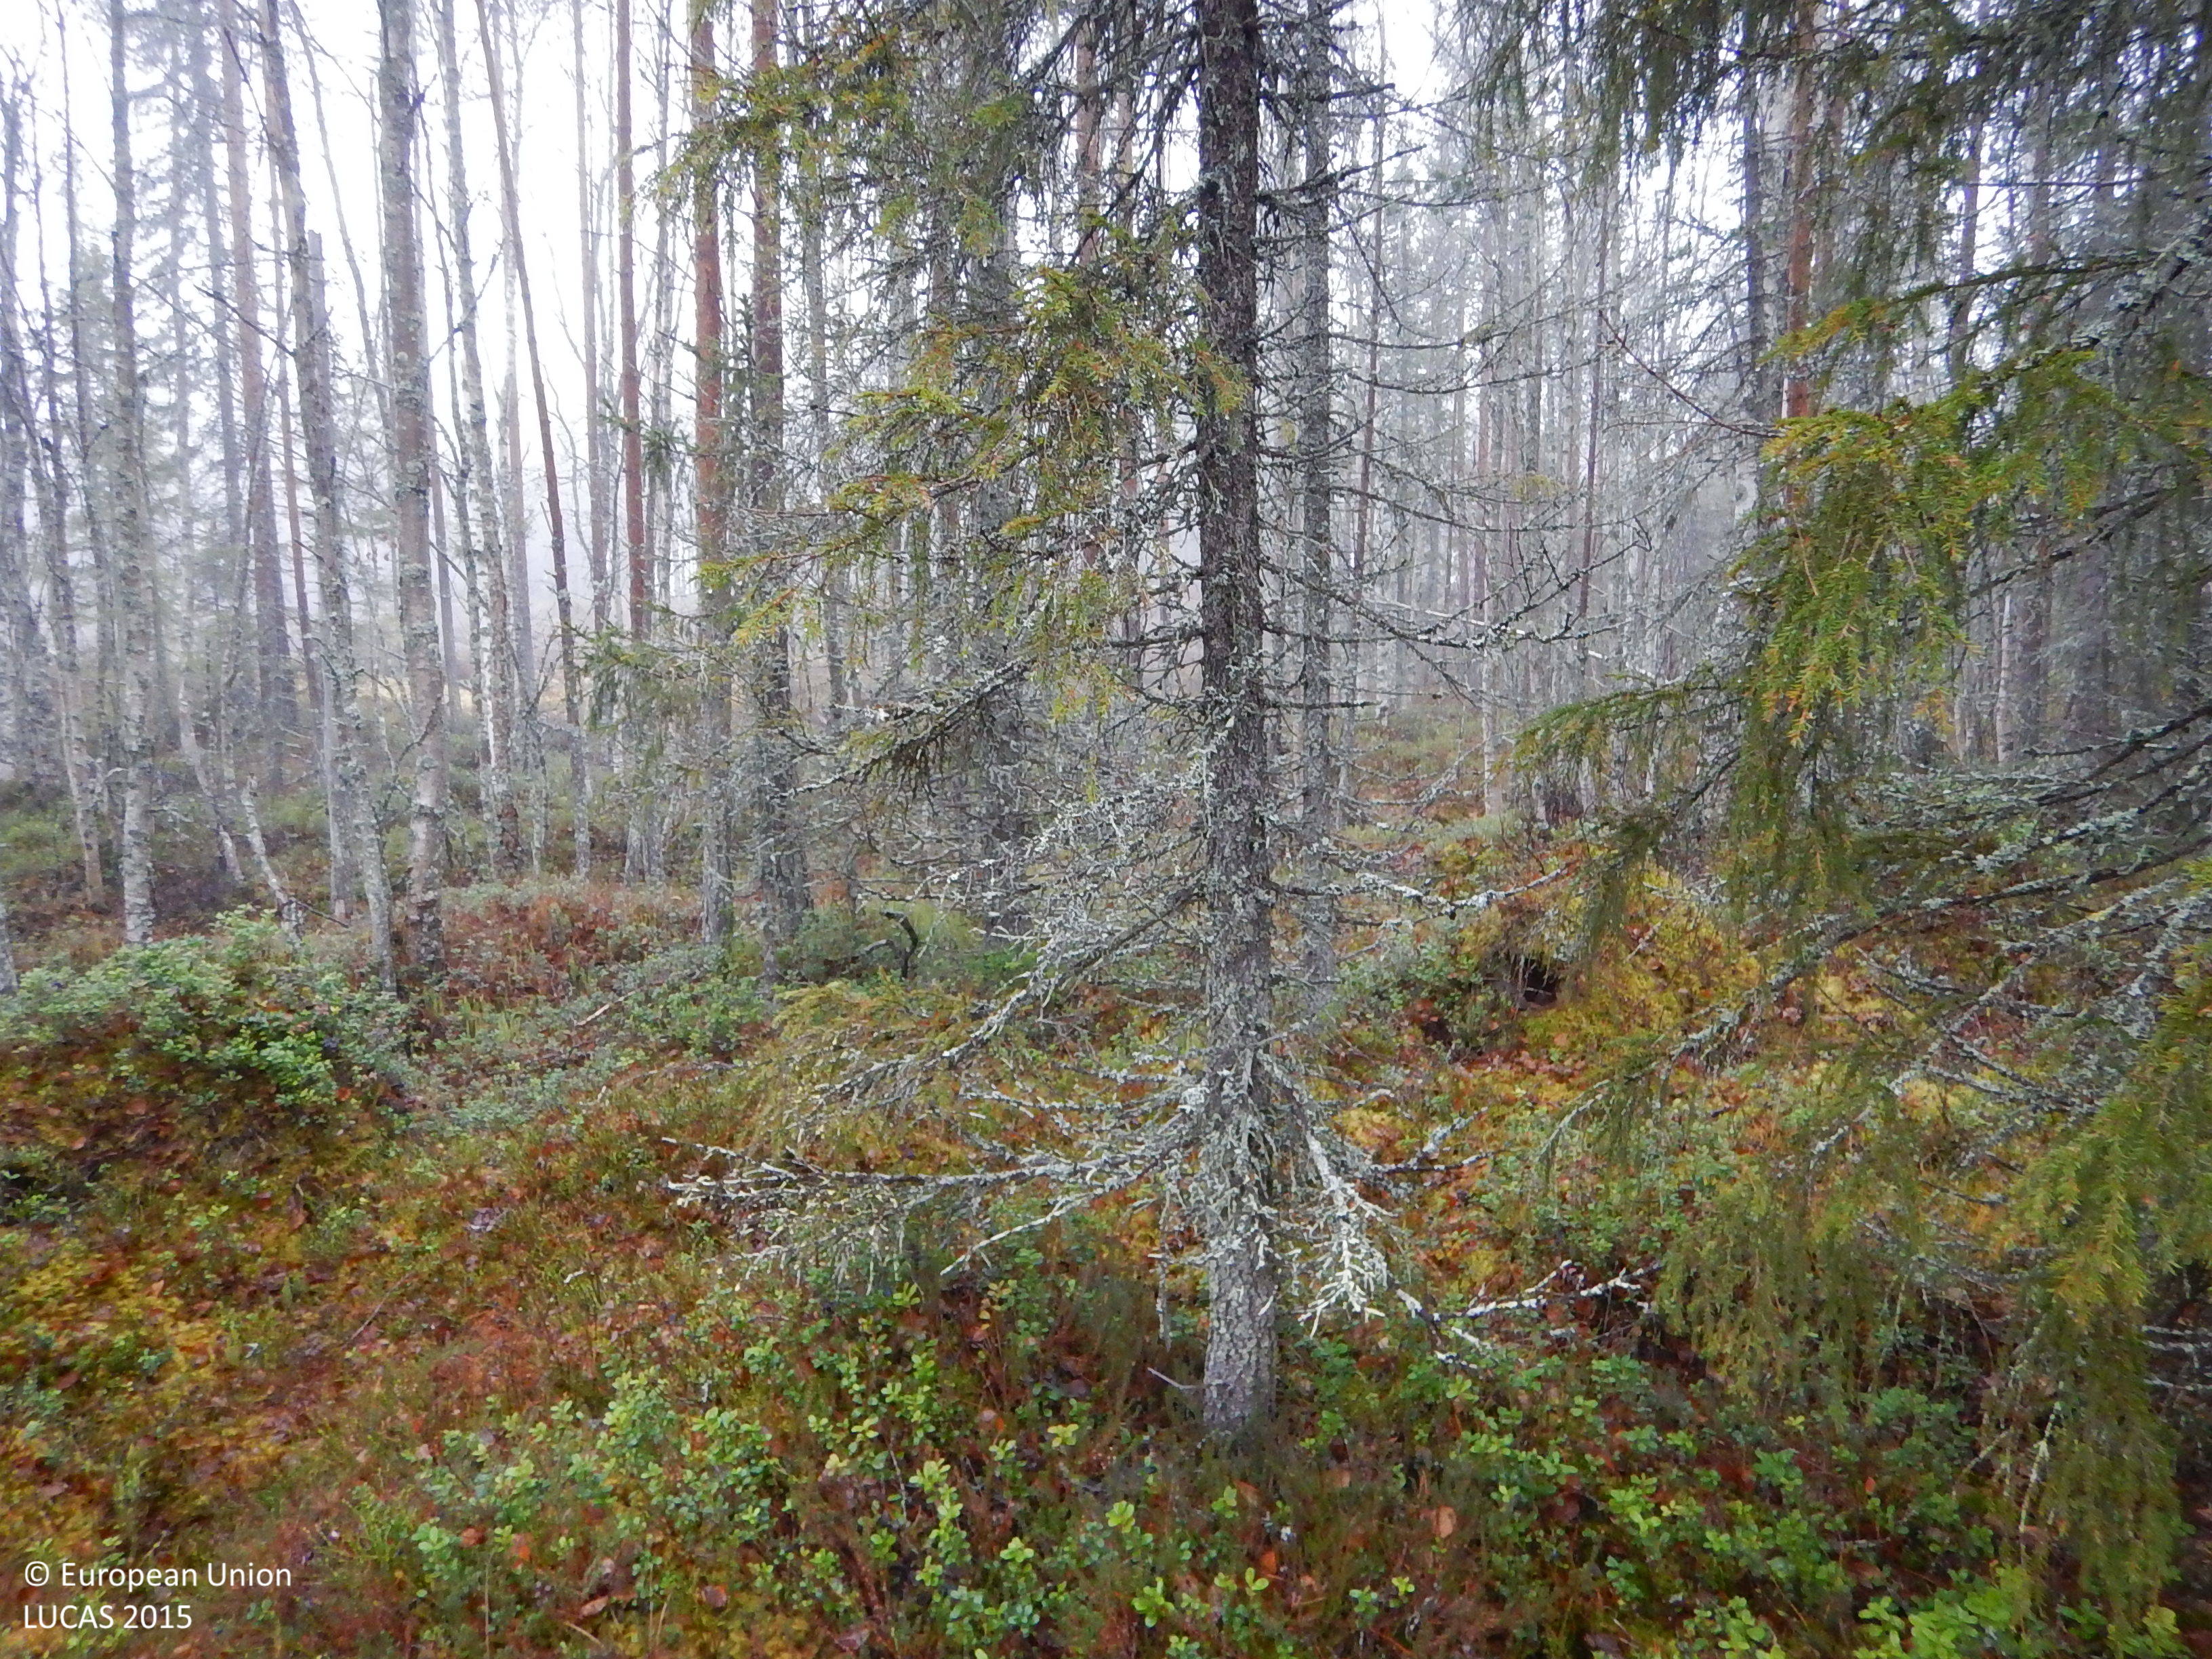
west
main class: Woodland
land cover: Pine dominated mixed woodland
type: mire and swamp forests
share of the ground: 50 - 75 %
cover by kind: coniferous forest trees 35 %, lichens and mosses 25 %, broadleaved forest trees 20 %, shrubs 15 %, herbaceous plants 5 %
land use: Forestry
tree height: > 5 m
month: November
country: SE
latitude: 65.1359
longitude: 20.3503
